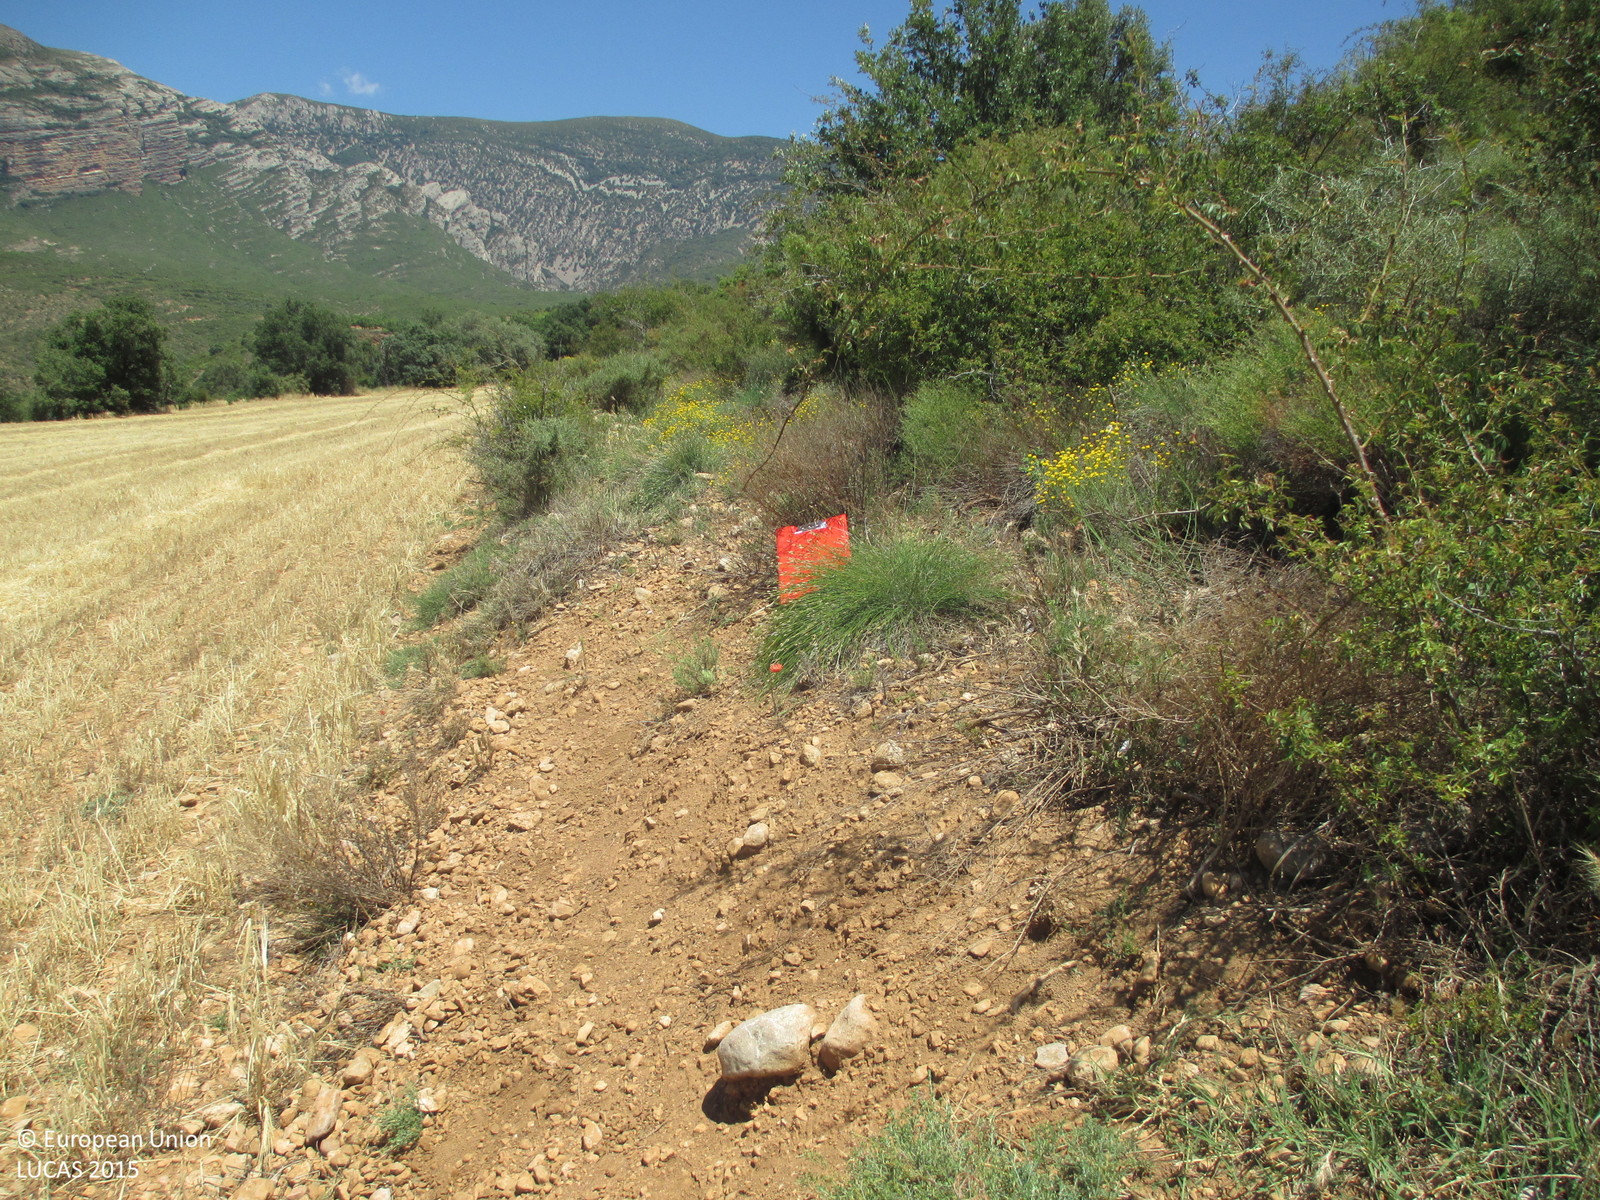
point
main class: Shrubland
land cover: Shrubland with sparse tree cover
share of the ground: > 75 %
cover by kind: shrubs 90 %, broadleaved forest trees 5 %, herbaceous plants 5 %
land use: Semi-natural and natural areas not in use
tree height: < 5 m
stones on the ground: < 10 %
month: June
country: ES
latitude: 42.2307
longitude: -0.3585
